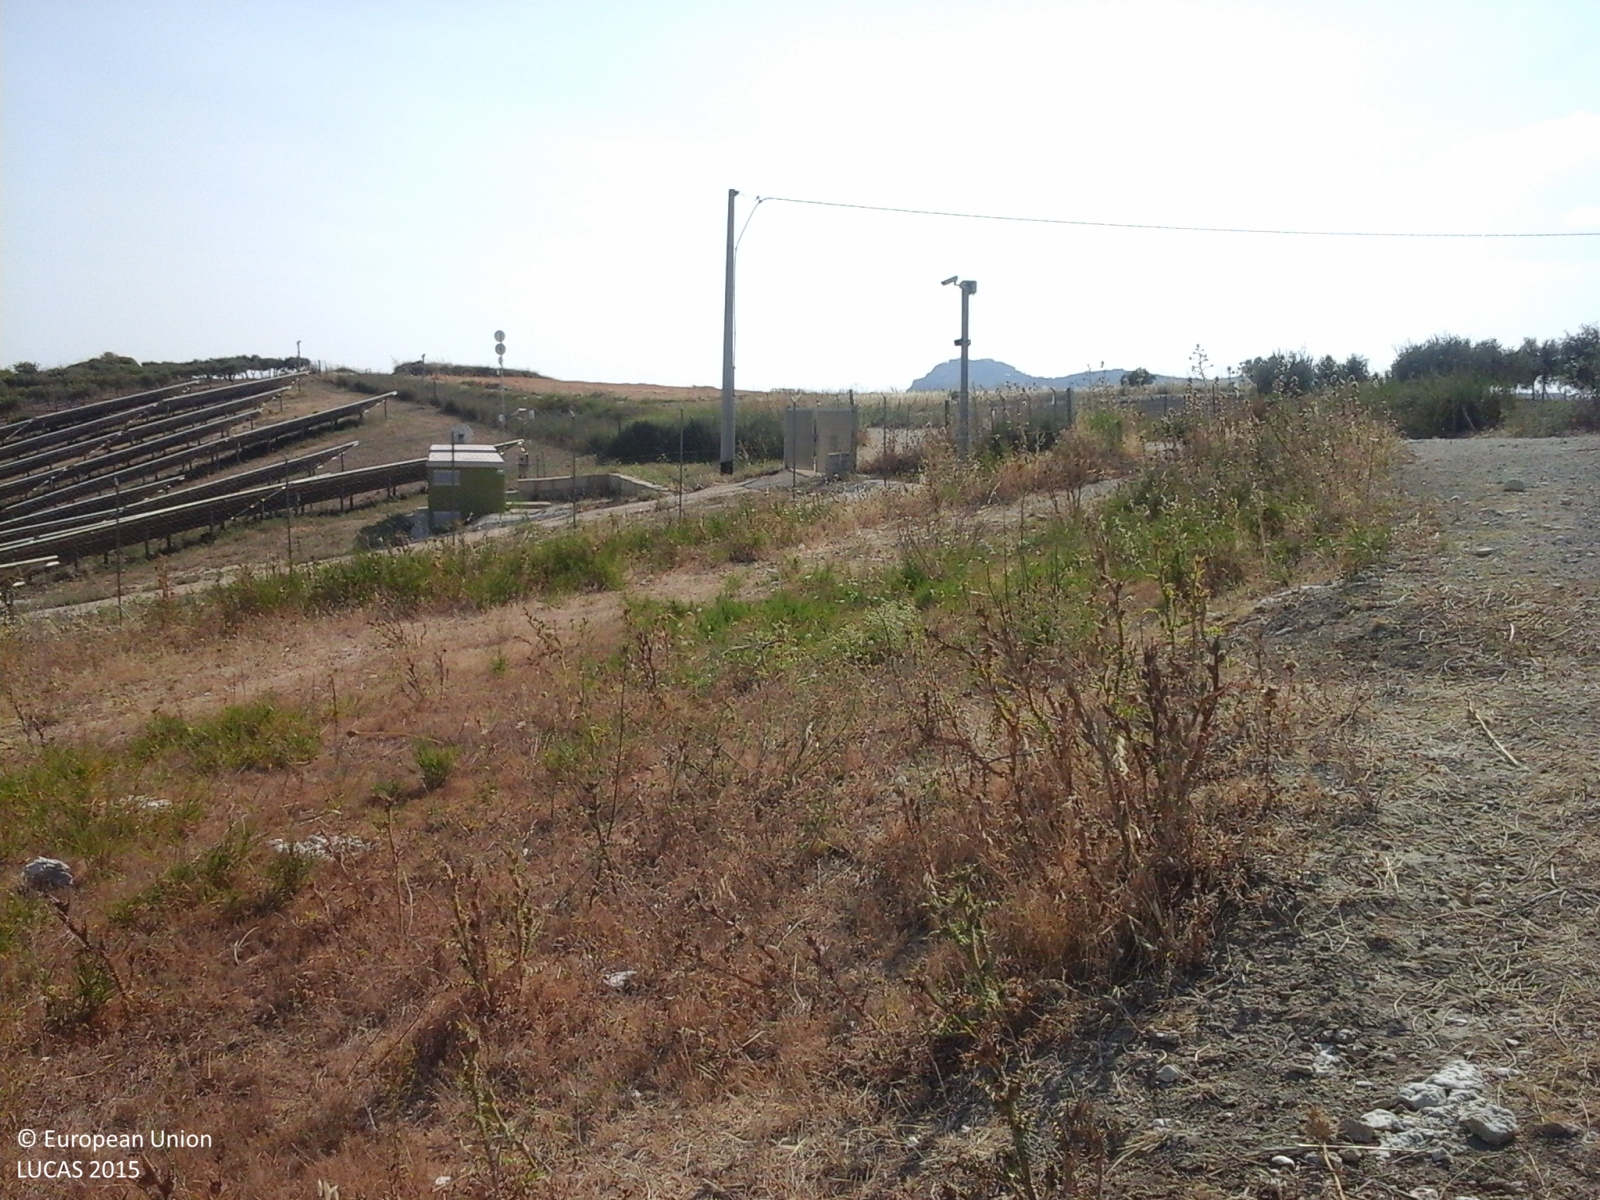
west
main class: Grassland
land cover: Grassland without tree/shrub cover
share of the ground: > 75 %
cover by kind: herbaceous plants 100 %
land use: Agriculture (excluding fallow land and kitchen gardens)
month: July
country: IT
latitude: 37.5309
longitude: 13.1782
